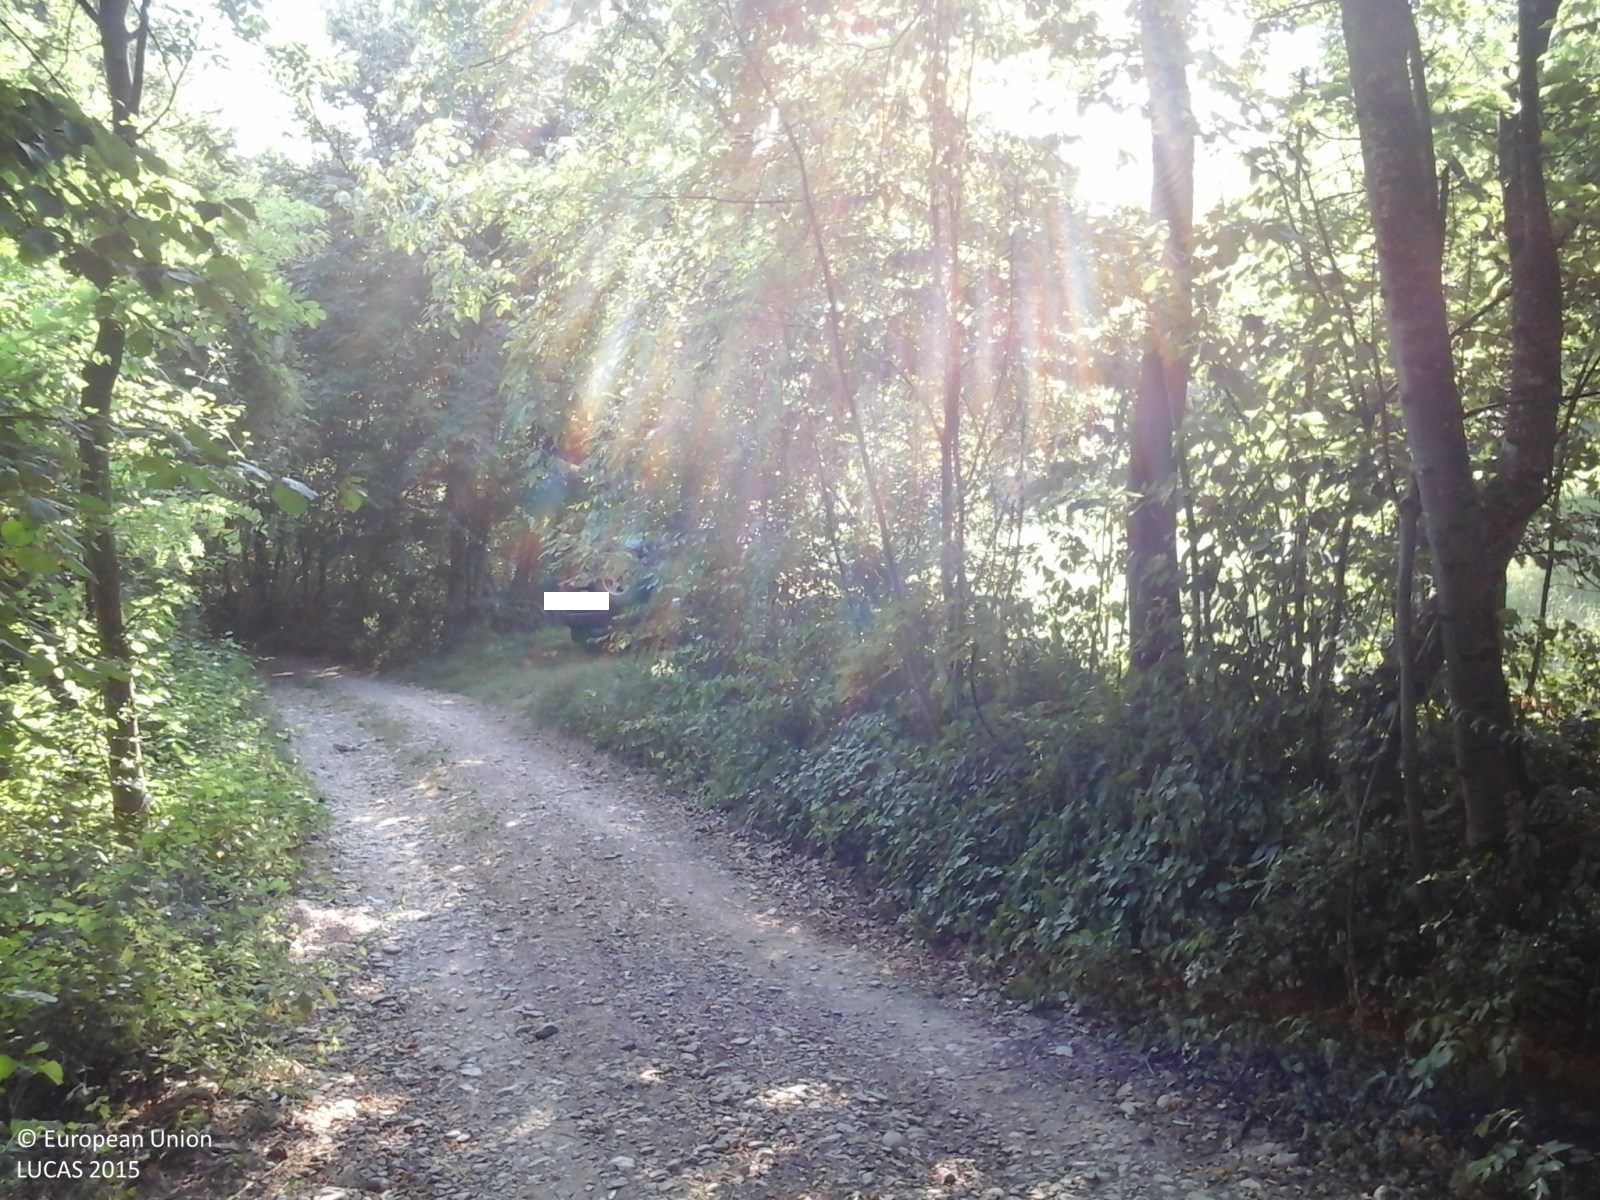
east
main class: Grassland
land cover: Grassland without tree/shrub cover
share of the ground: > 75 %
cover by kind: herbaceous plants 100 %
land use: Agriculture (excluding fallow land and kitchen gardens)
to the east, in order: Grassland without tree/shrub cover; Fences; Managed hedges; Grassland without tree/shrub cover; Fences; Grassland without tree/shrub cover; Fences; Broadleaved woodland; Grassland without tree/shrub cover; Fences; Paved roads, cycling and walking lanes; Grassland without tree/shrub cover; Other fresh vegetables; Broadleaved woodland
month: July
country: IT
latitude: 46.0271
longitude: 11.9481
